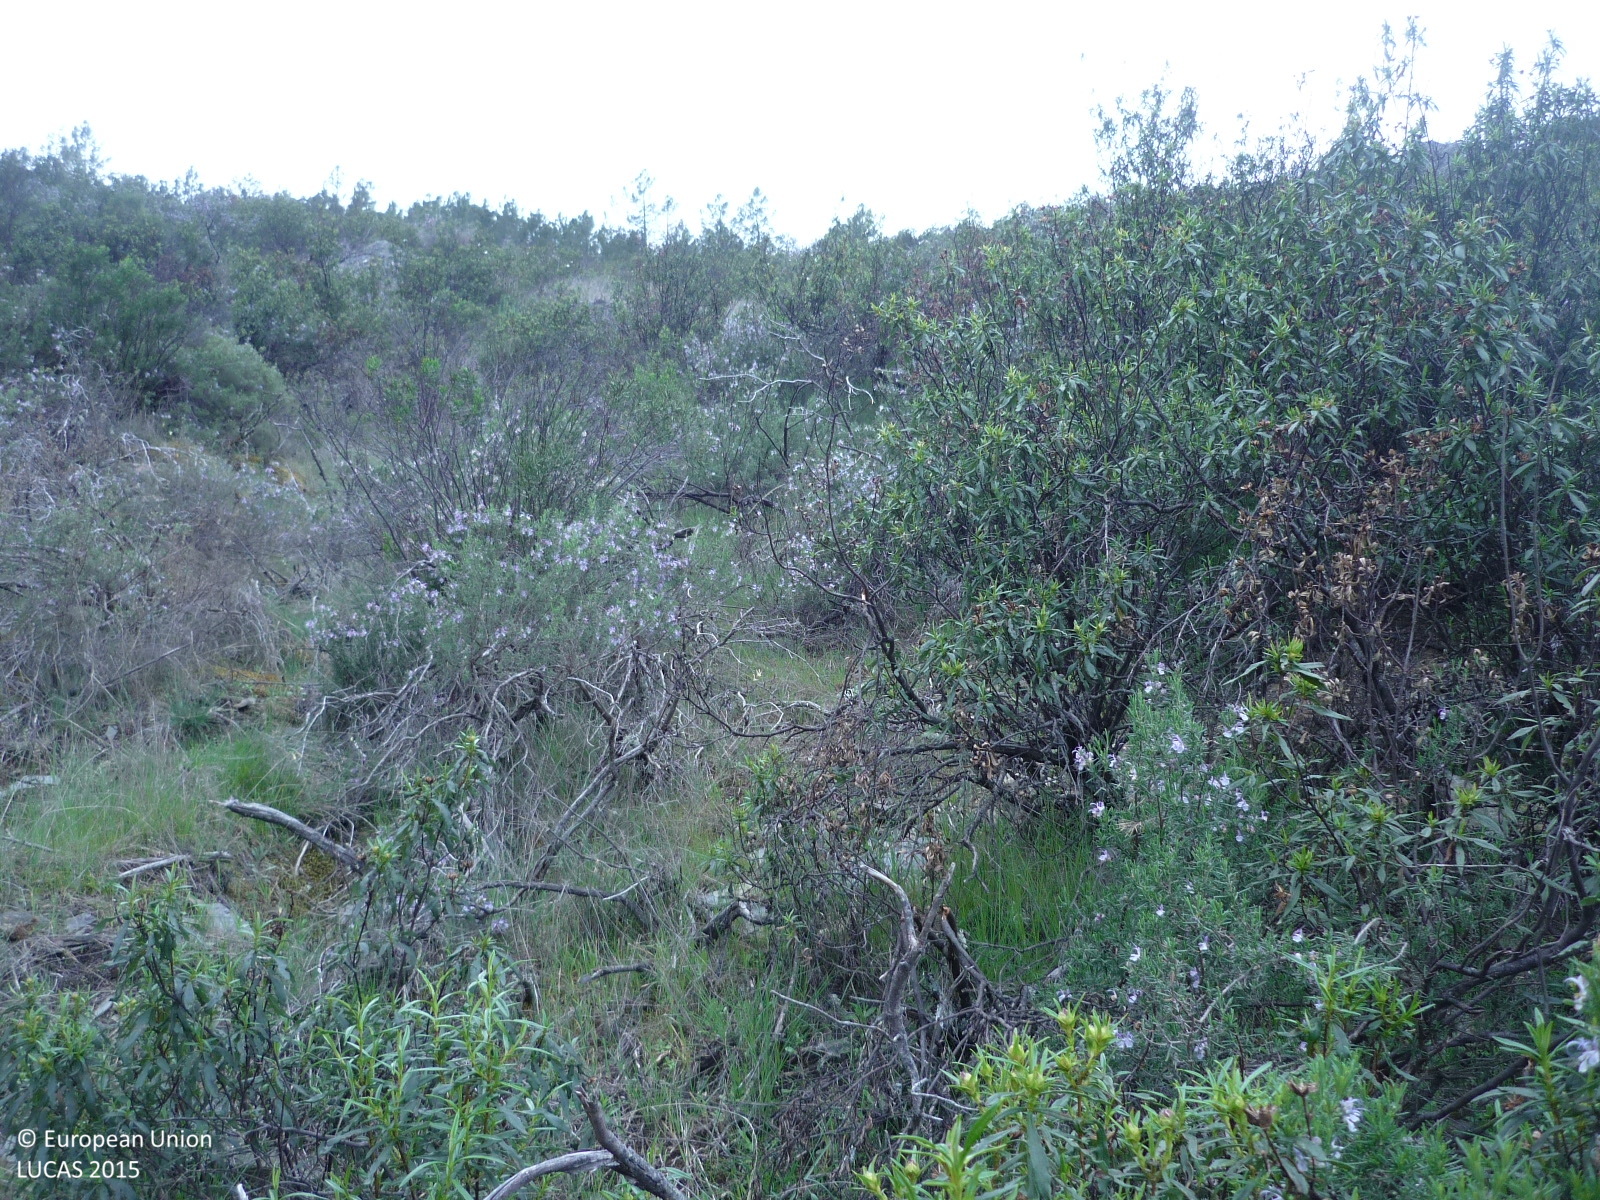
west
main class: Shrubland
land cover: Shrubland with sparse tree cover
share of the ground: > 75 %
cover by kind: shrubs 85 %, herbaceous plants 10 %, coniferous forest trees 5 %
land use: Semi-natural and natural areas not in use
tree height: > 5 m
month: April
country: ES
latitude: 40.9408
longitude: -3.4990
